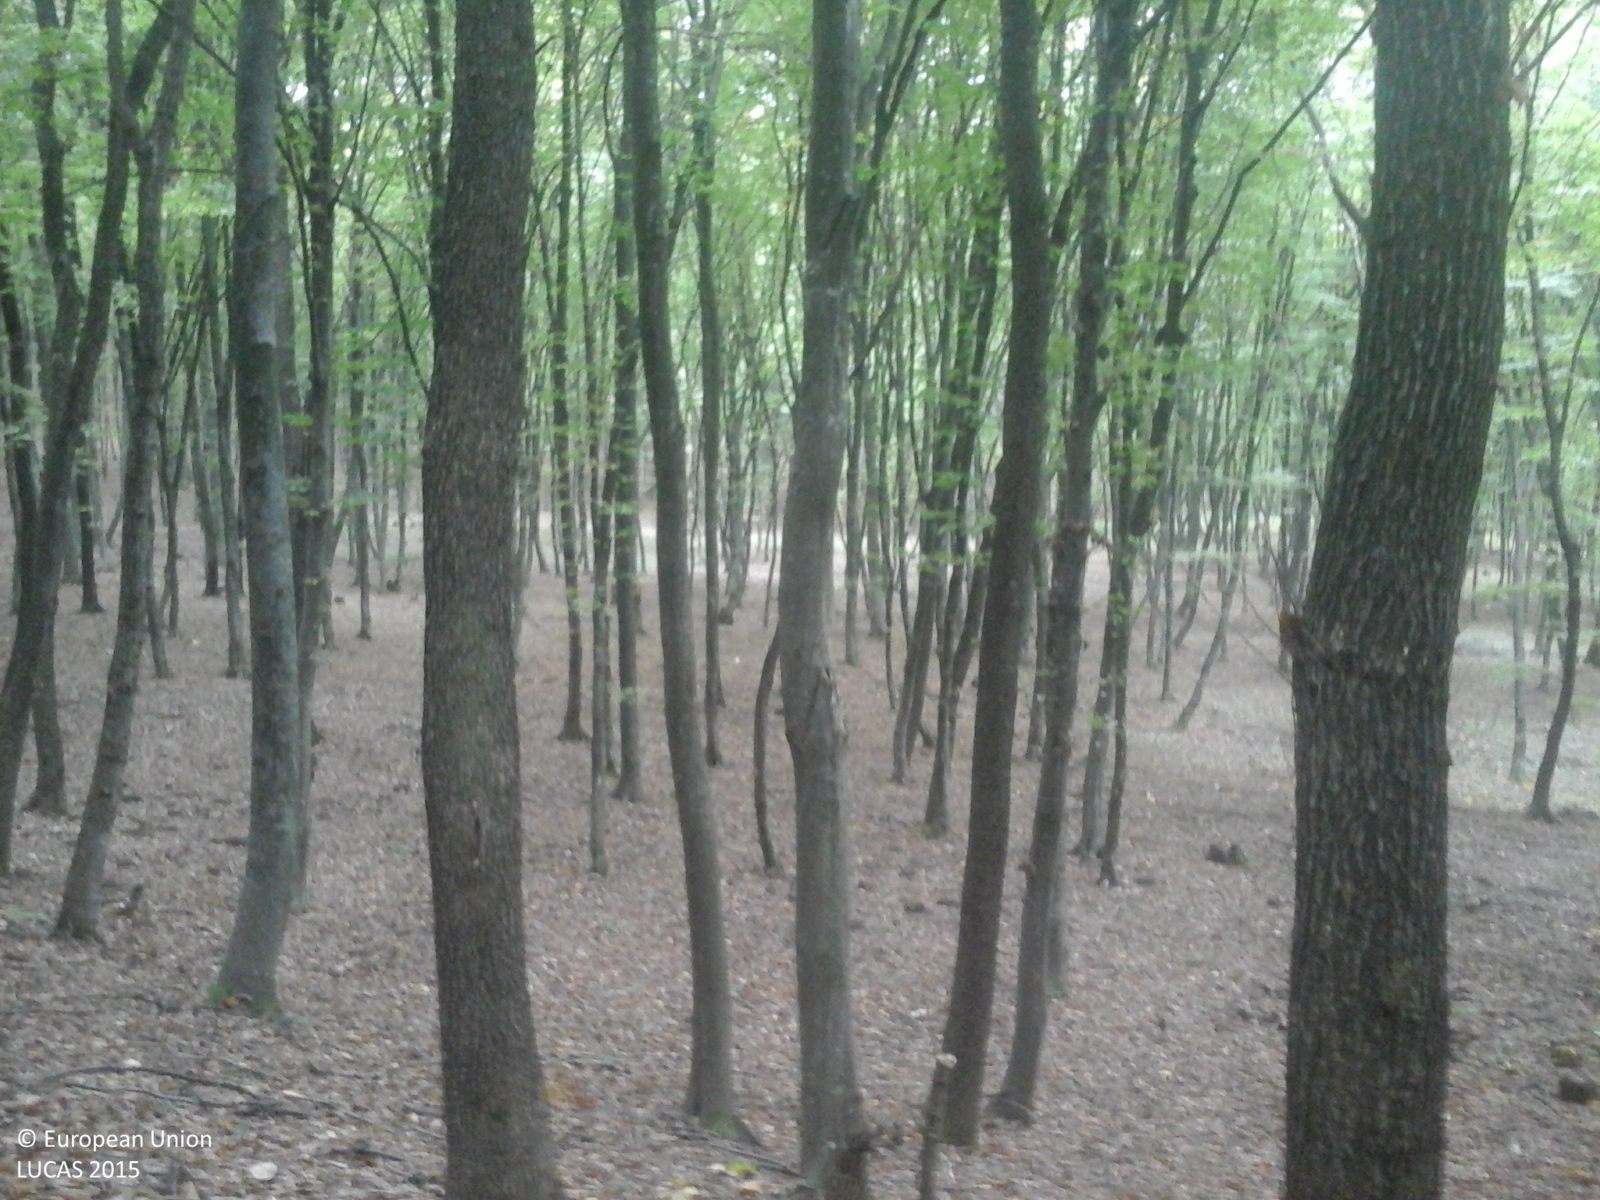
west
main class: Woodland
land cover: Broadleaved woodland
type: acidophilous oak and oak-birch forest
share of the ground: > 75 %
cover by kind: broadleaved forest trees 100 %
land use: Forestry
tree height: > 5 m
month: October
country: RO
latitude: 46.1333
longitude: 24.8338
